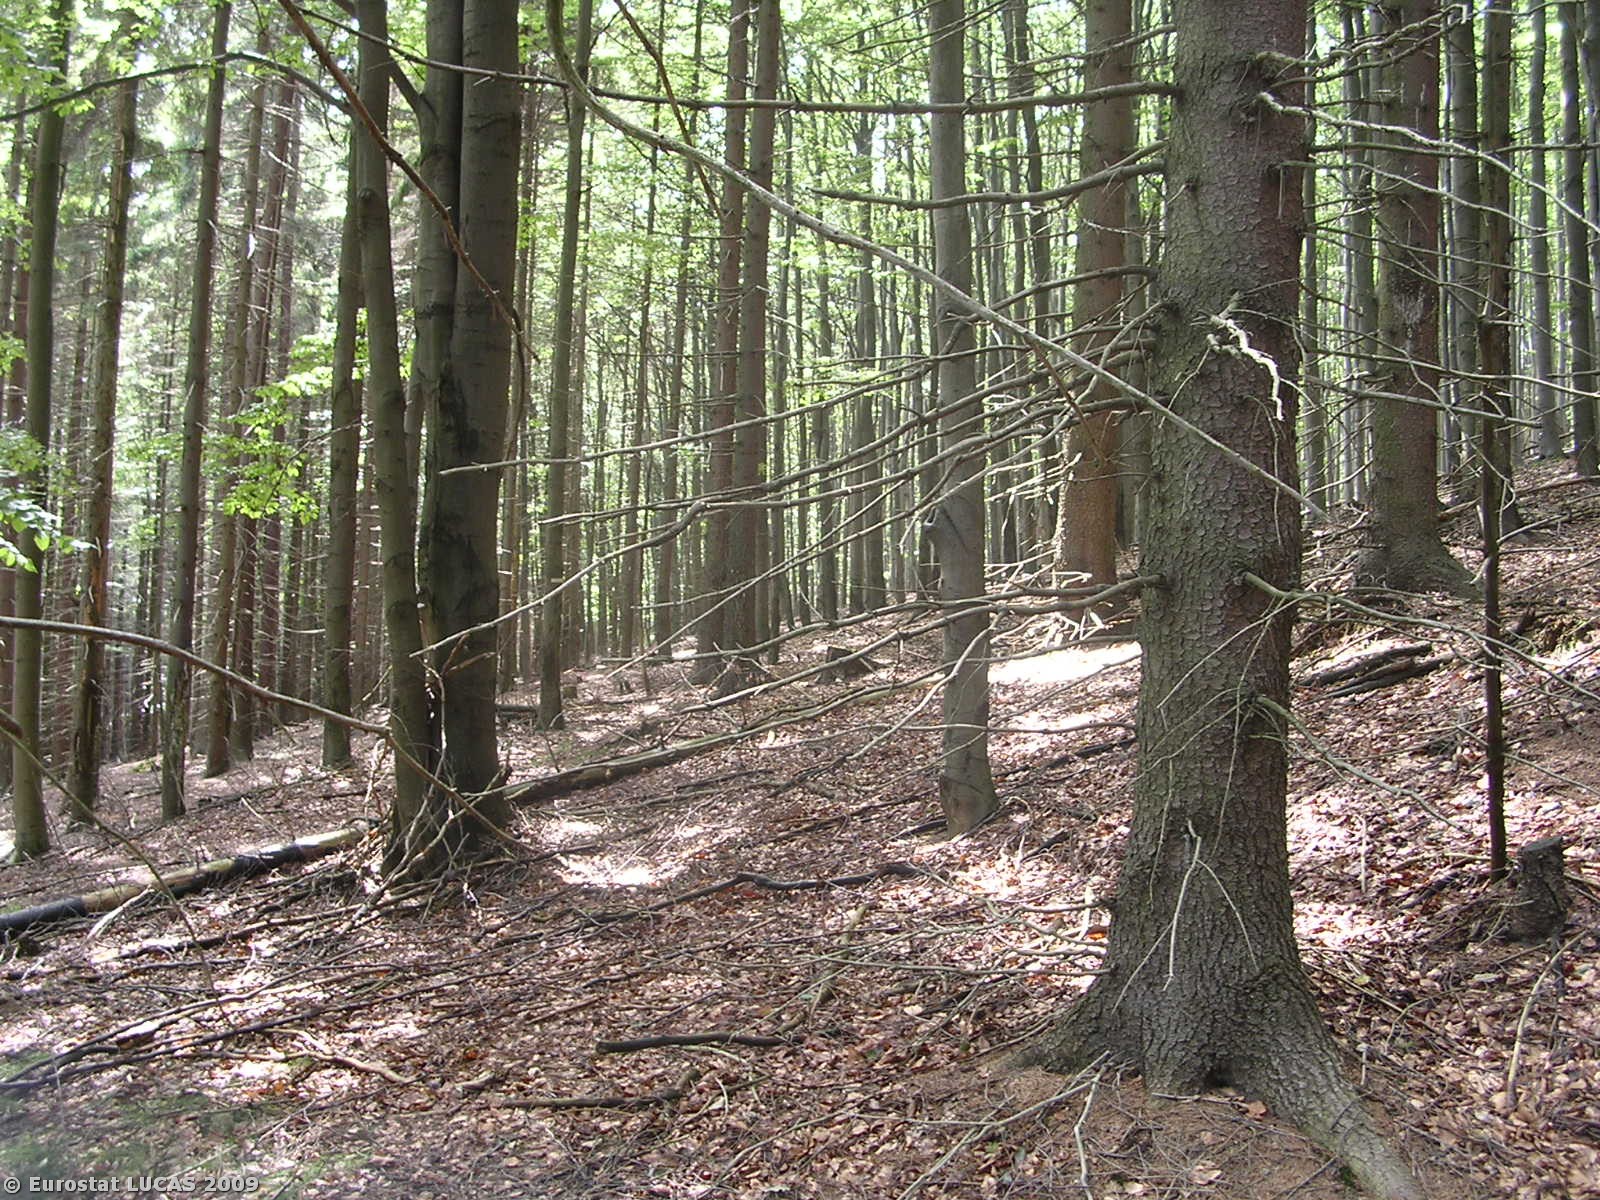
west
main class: Woodland
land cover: Mixed woodland
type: hemiboreal forest and nemoral coniferous forest and mixed broadleaved-coniferous forest
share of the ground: > 75 %
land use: Forestry
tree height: > 5 m
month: July
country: CZ
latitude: 50.8315
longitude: 14.5596
